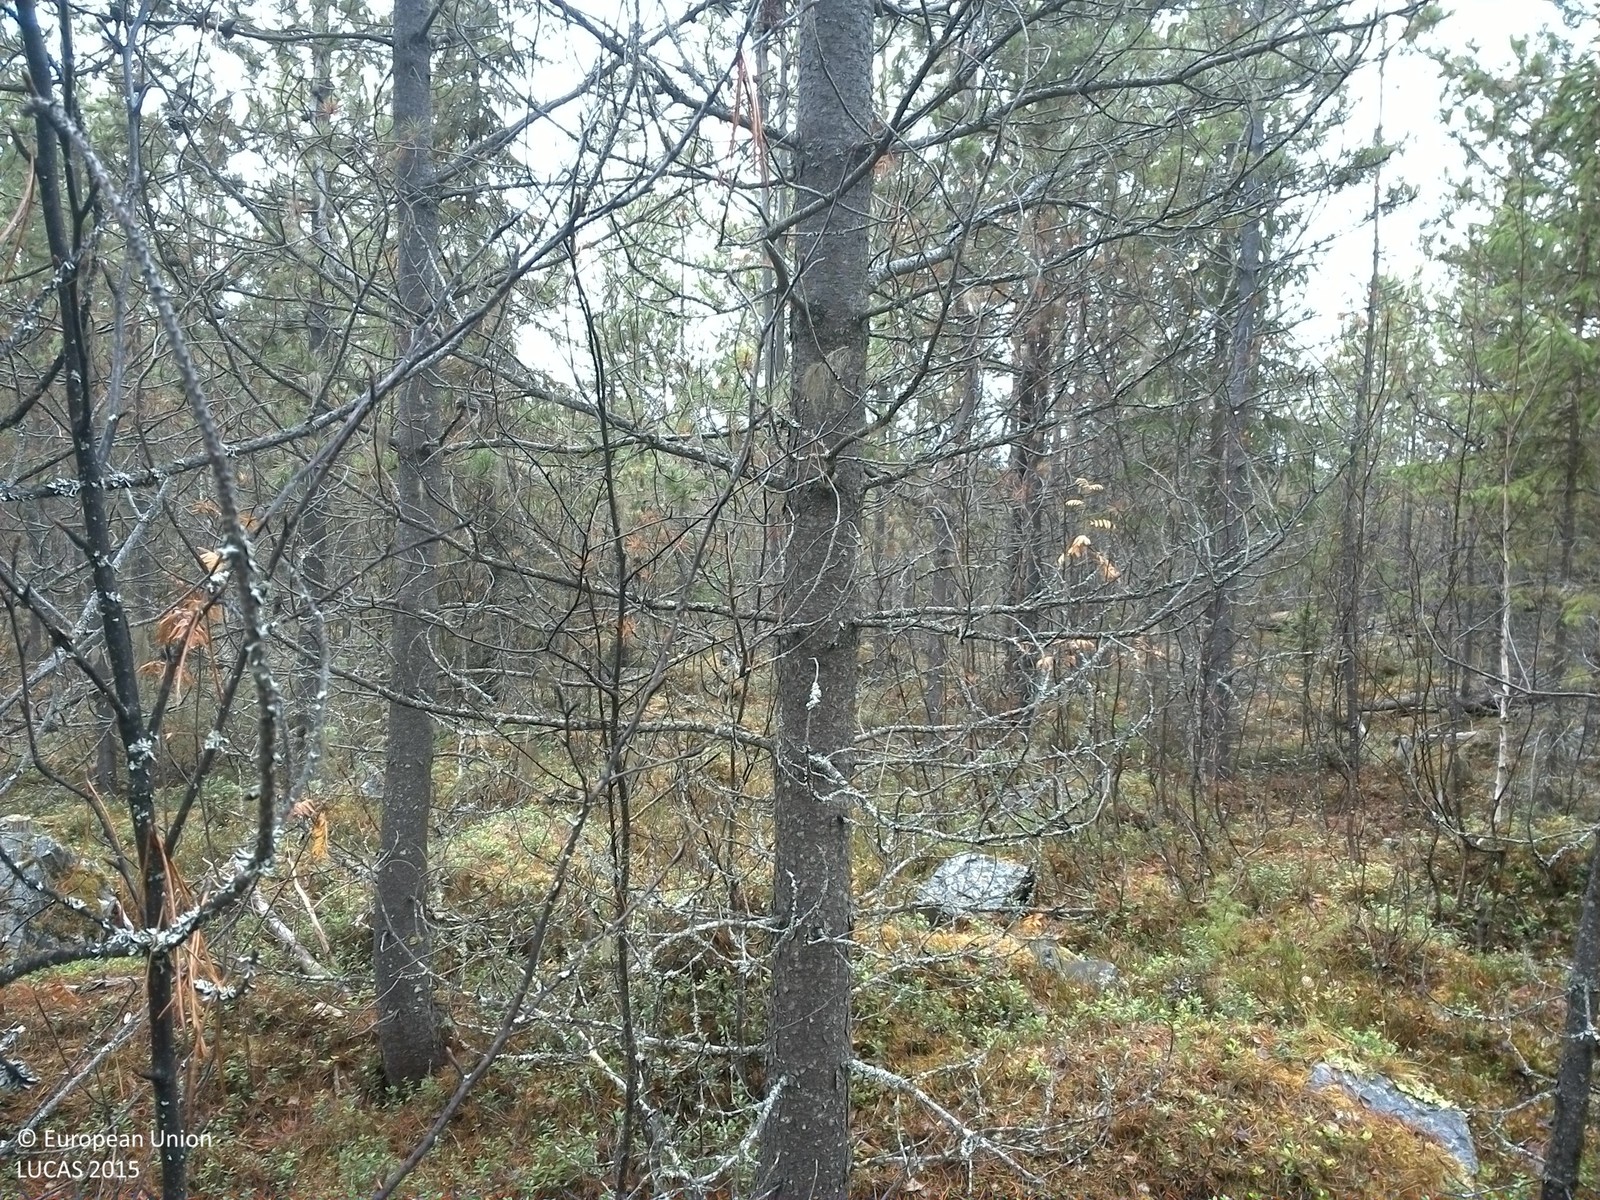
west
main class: Woodland
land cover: Pine dominated coniferous woodland
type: exotic forest
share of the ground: 25 - 50 %
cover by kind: coniferous forest trees 40 %, shrubs 35 %, lichens and mosses 15 %, broadleaved forest trees 5 %, consolidated bare surface 5 %
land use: Forestry
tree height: > 5 m
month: October
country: SE
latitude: 64.3405
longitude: 15.4560
